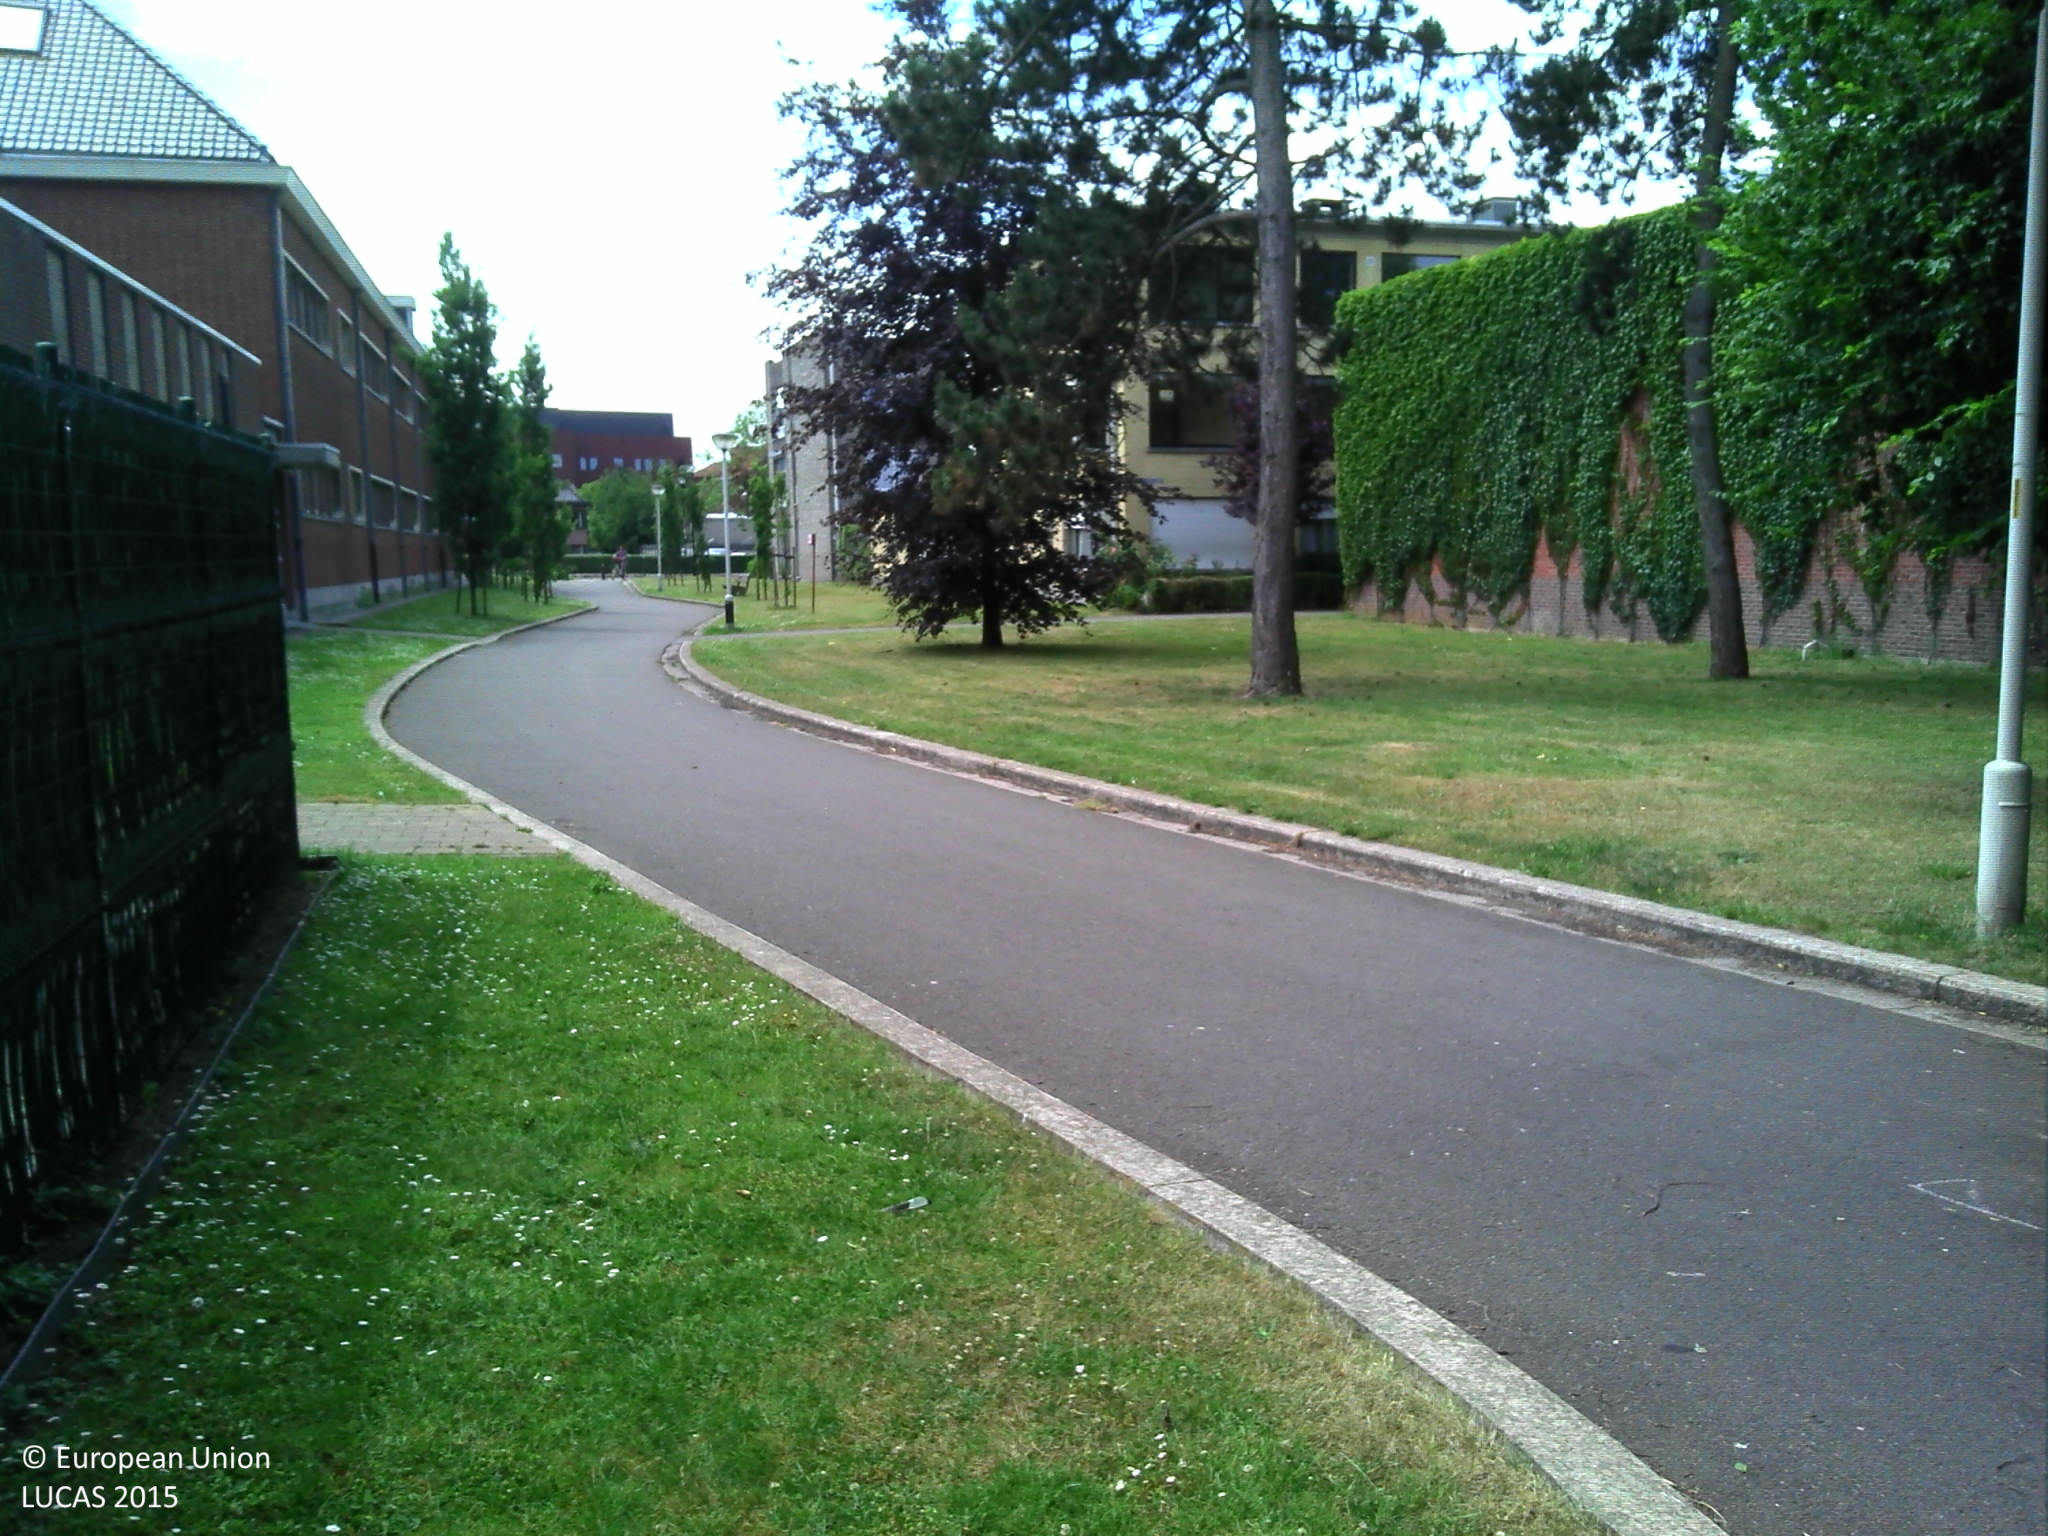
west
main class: Grassland
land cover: Grassland without tree/shrub cover
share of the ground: > 75 %
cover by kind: herbaceous plants 100 %
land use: Residential
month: June
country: BE
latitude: 51.2111
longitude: 4.2547
